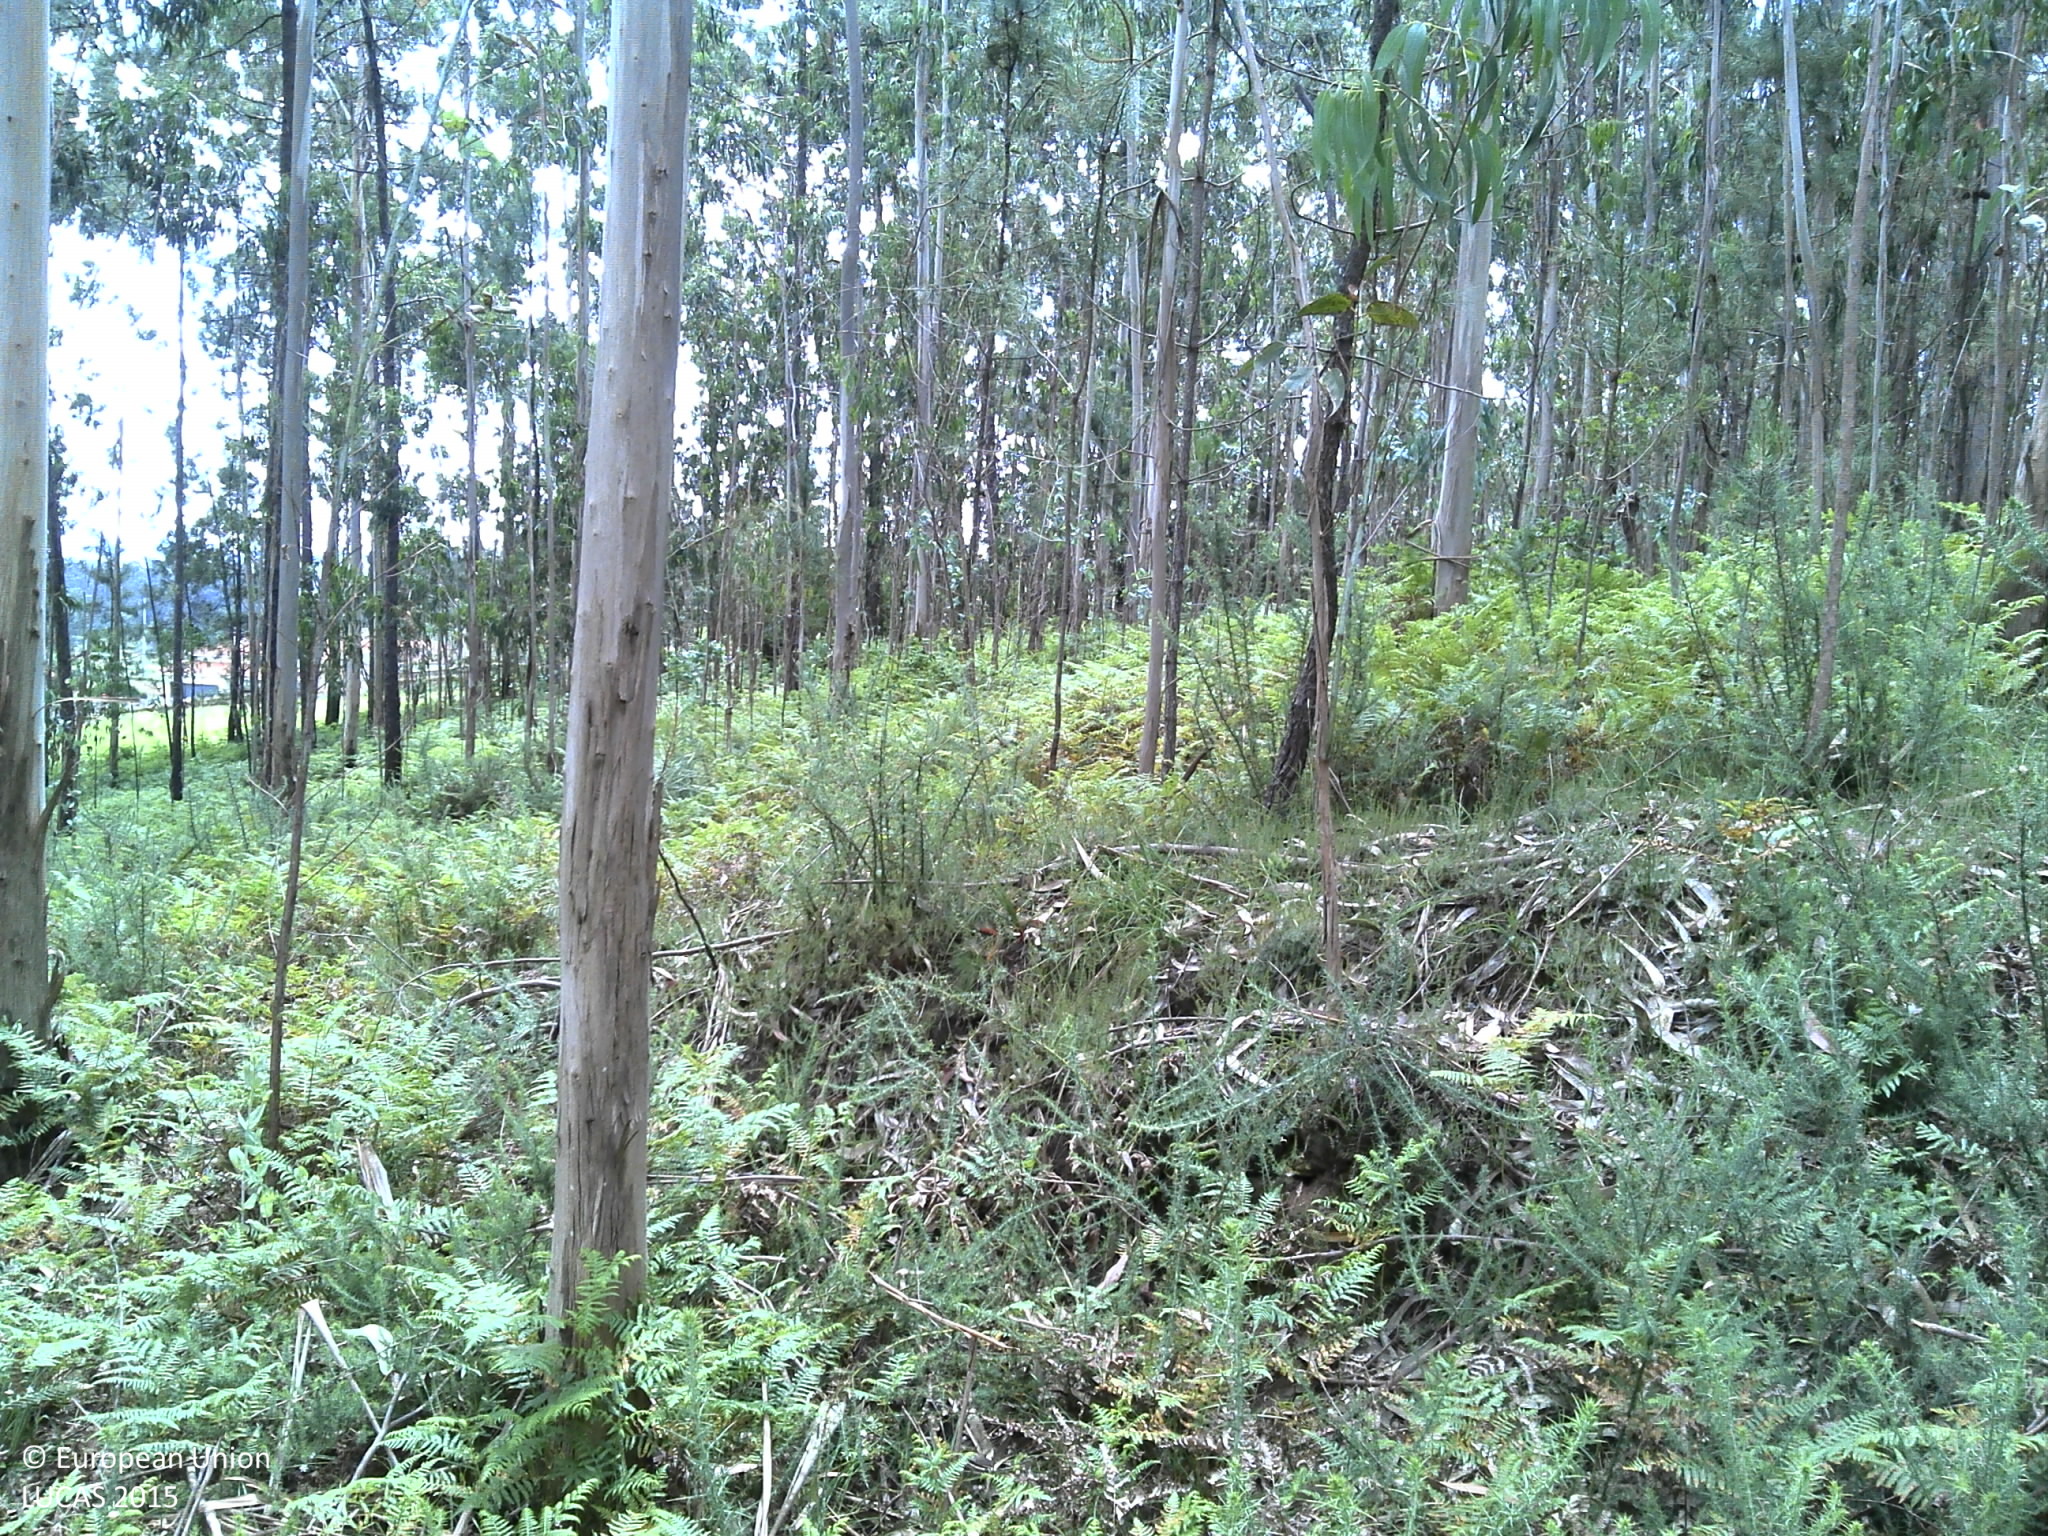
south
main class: Woodland
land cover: Broadleaved woodland
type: exotic forest
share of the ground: > 75 %
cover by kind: broadleaved forest trees 70 %, shrubs 20 %, herbaceous plants 5 %, unconsolidated bare surface 5 %
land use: Forestry
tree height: > 5 m
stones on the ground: < 10 %
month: May
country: PT
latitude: 41.4571
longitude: -8.6553
